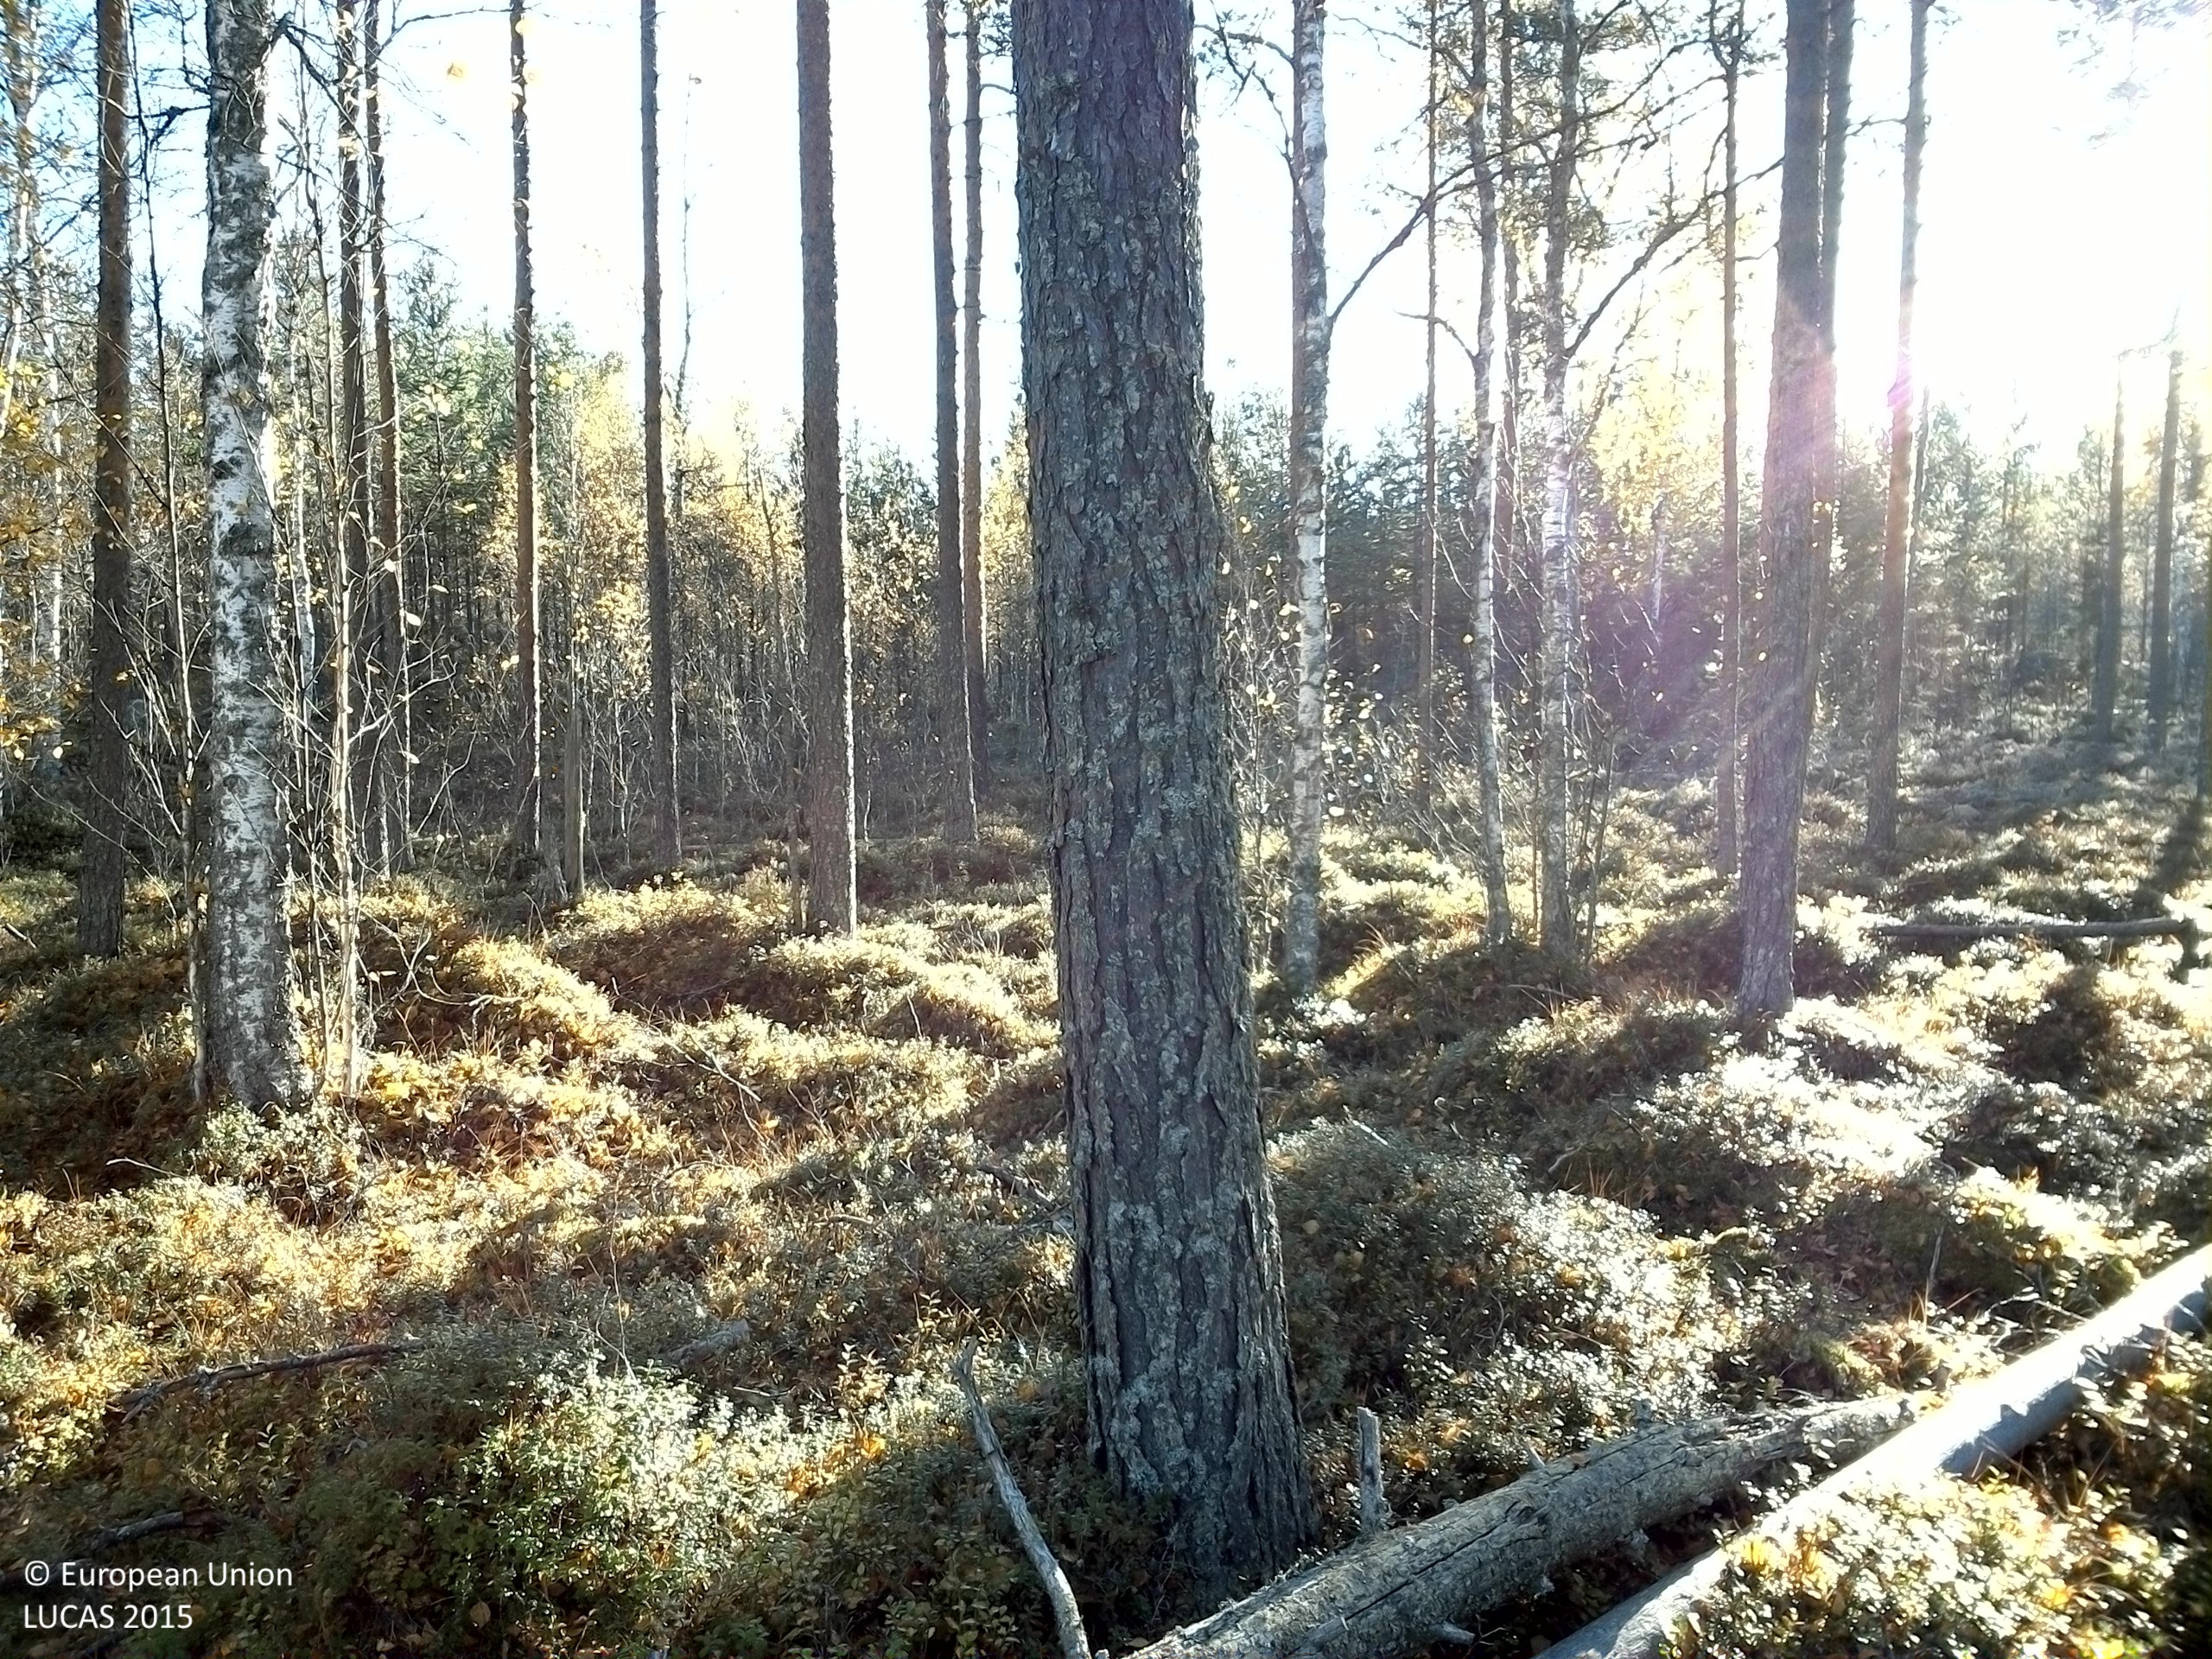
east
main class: Woodland
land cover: Pine dominated mixed woodland
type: boreal forest
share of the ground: 50 - 75 %
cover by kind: coniferous forest trees 35 %, shrubs 25 %, broadleaved forest trees 20 %, lichens and mosses 10 %, consolidated bare surface 10 %
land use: Forestry
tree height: > 5 m
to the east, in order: Pine dominated mixed woodland; Pine dominated coniferous woodland; Rocks and stones
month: October
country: SE
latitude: 61.3702
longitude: 15.0923
